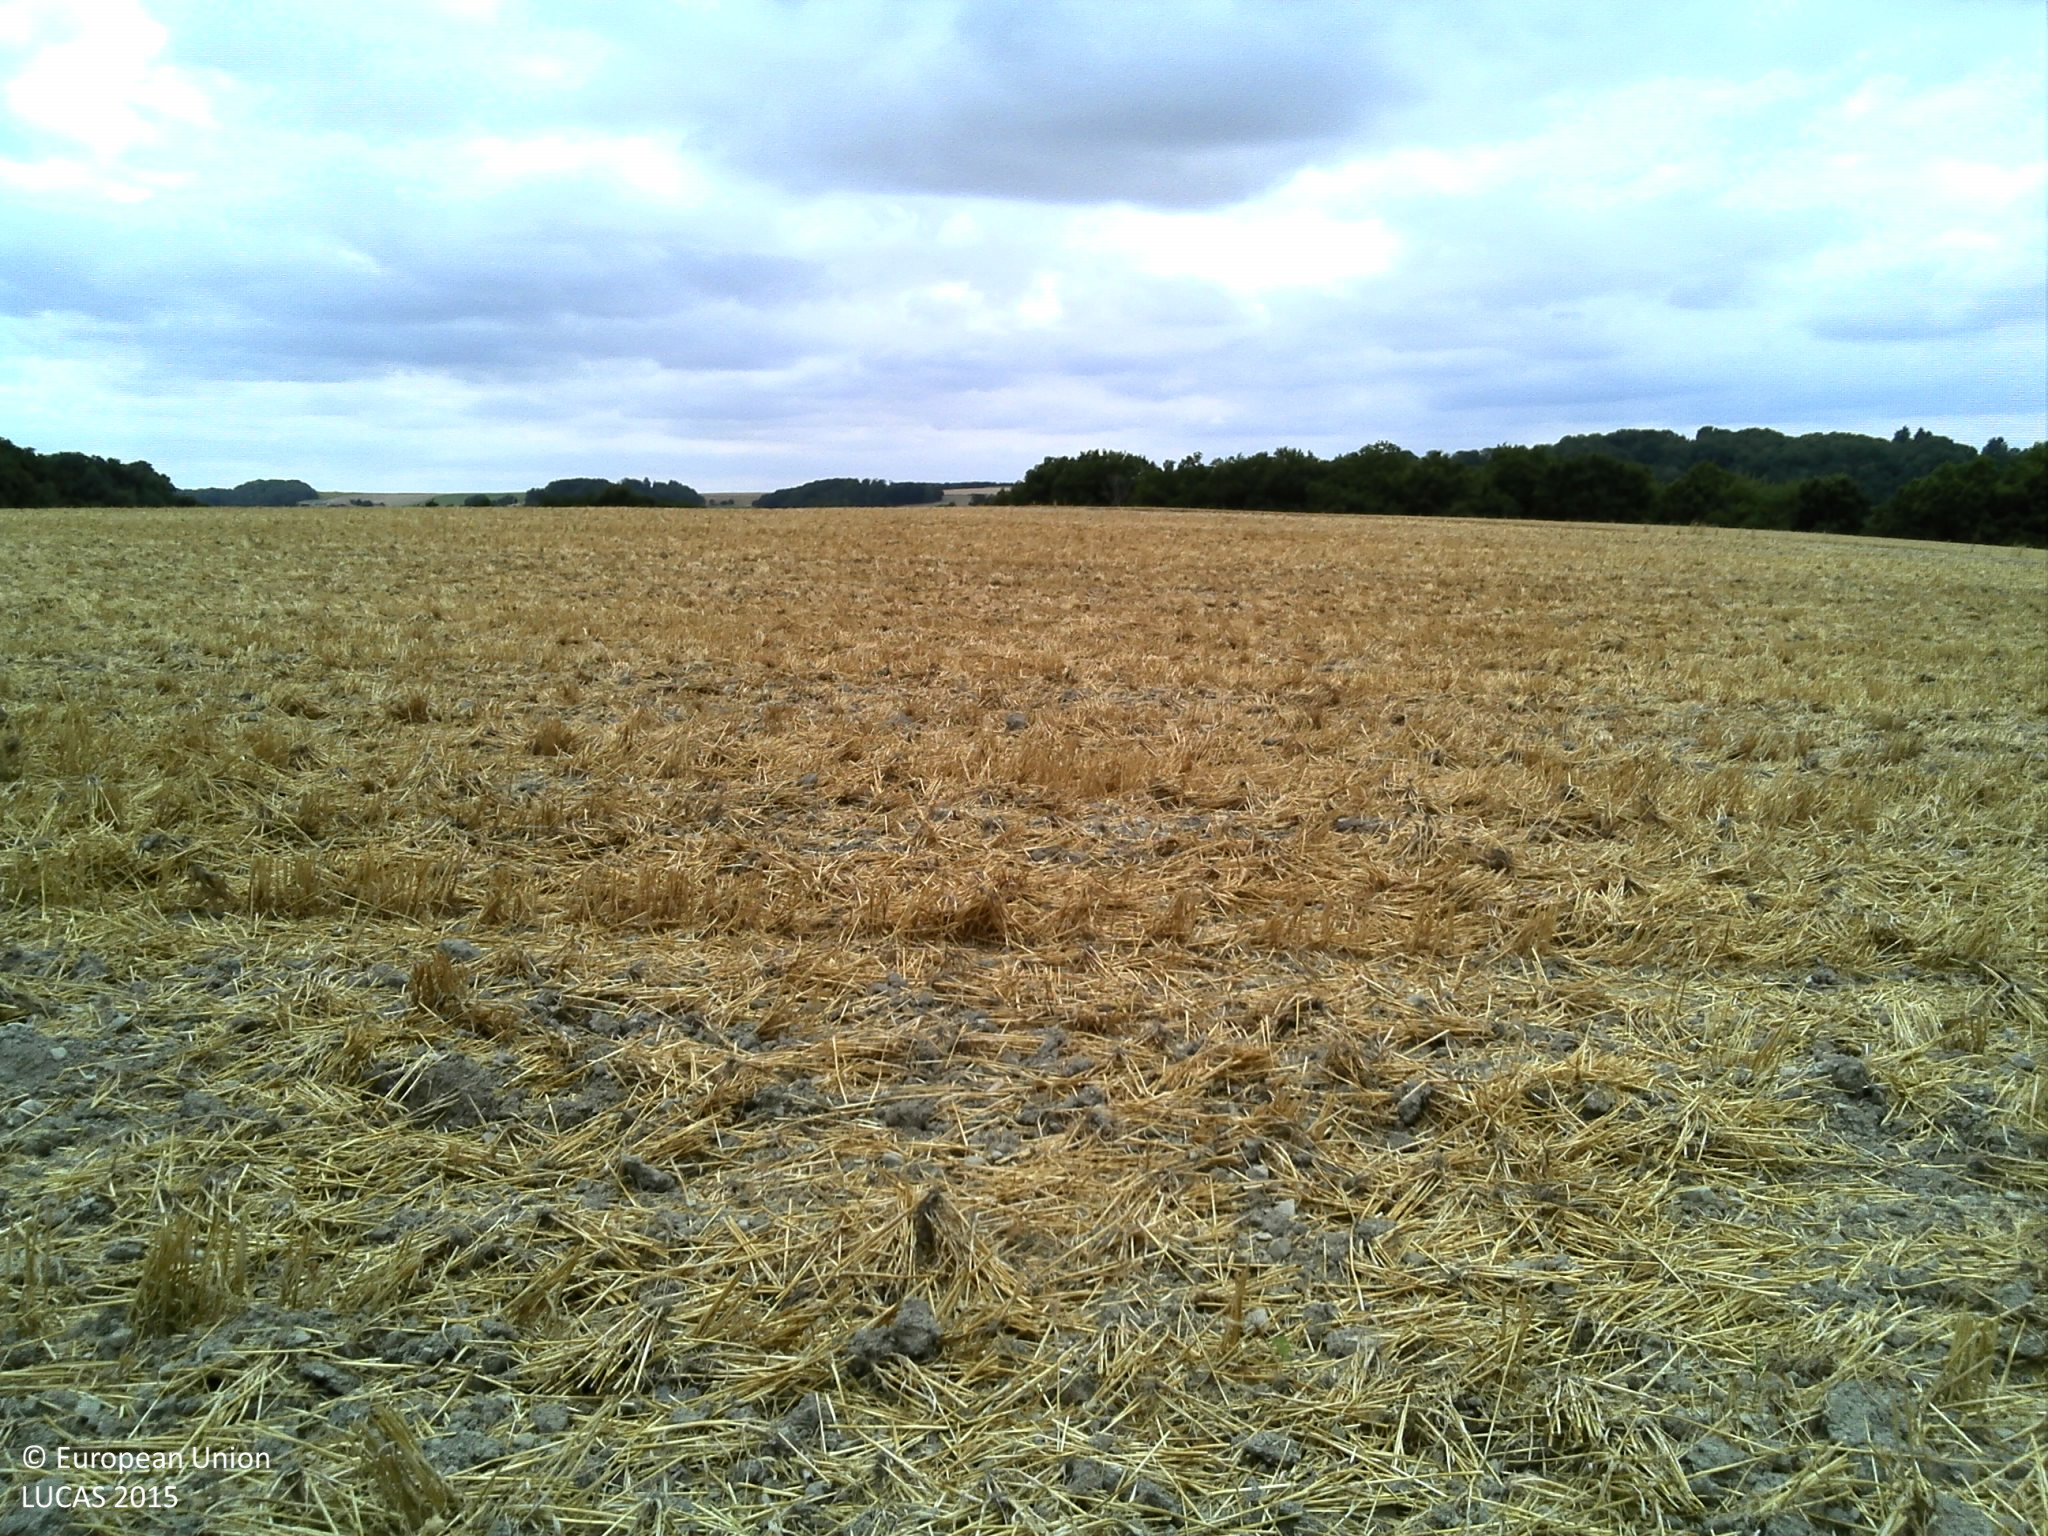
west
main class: Cropland
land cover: Barley
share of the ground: > 75 %
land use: Agriculture (excluding fallow land and kitchen gardens)
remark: Harvested field
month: July
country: FR
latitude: 49.1504
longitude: 4.8836
